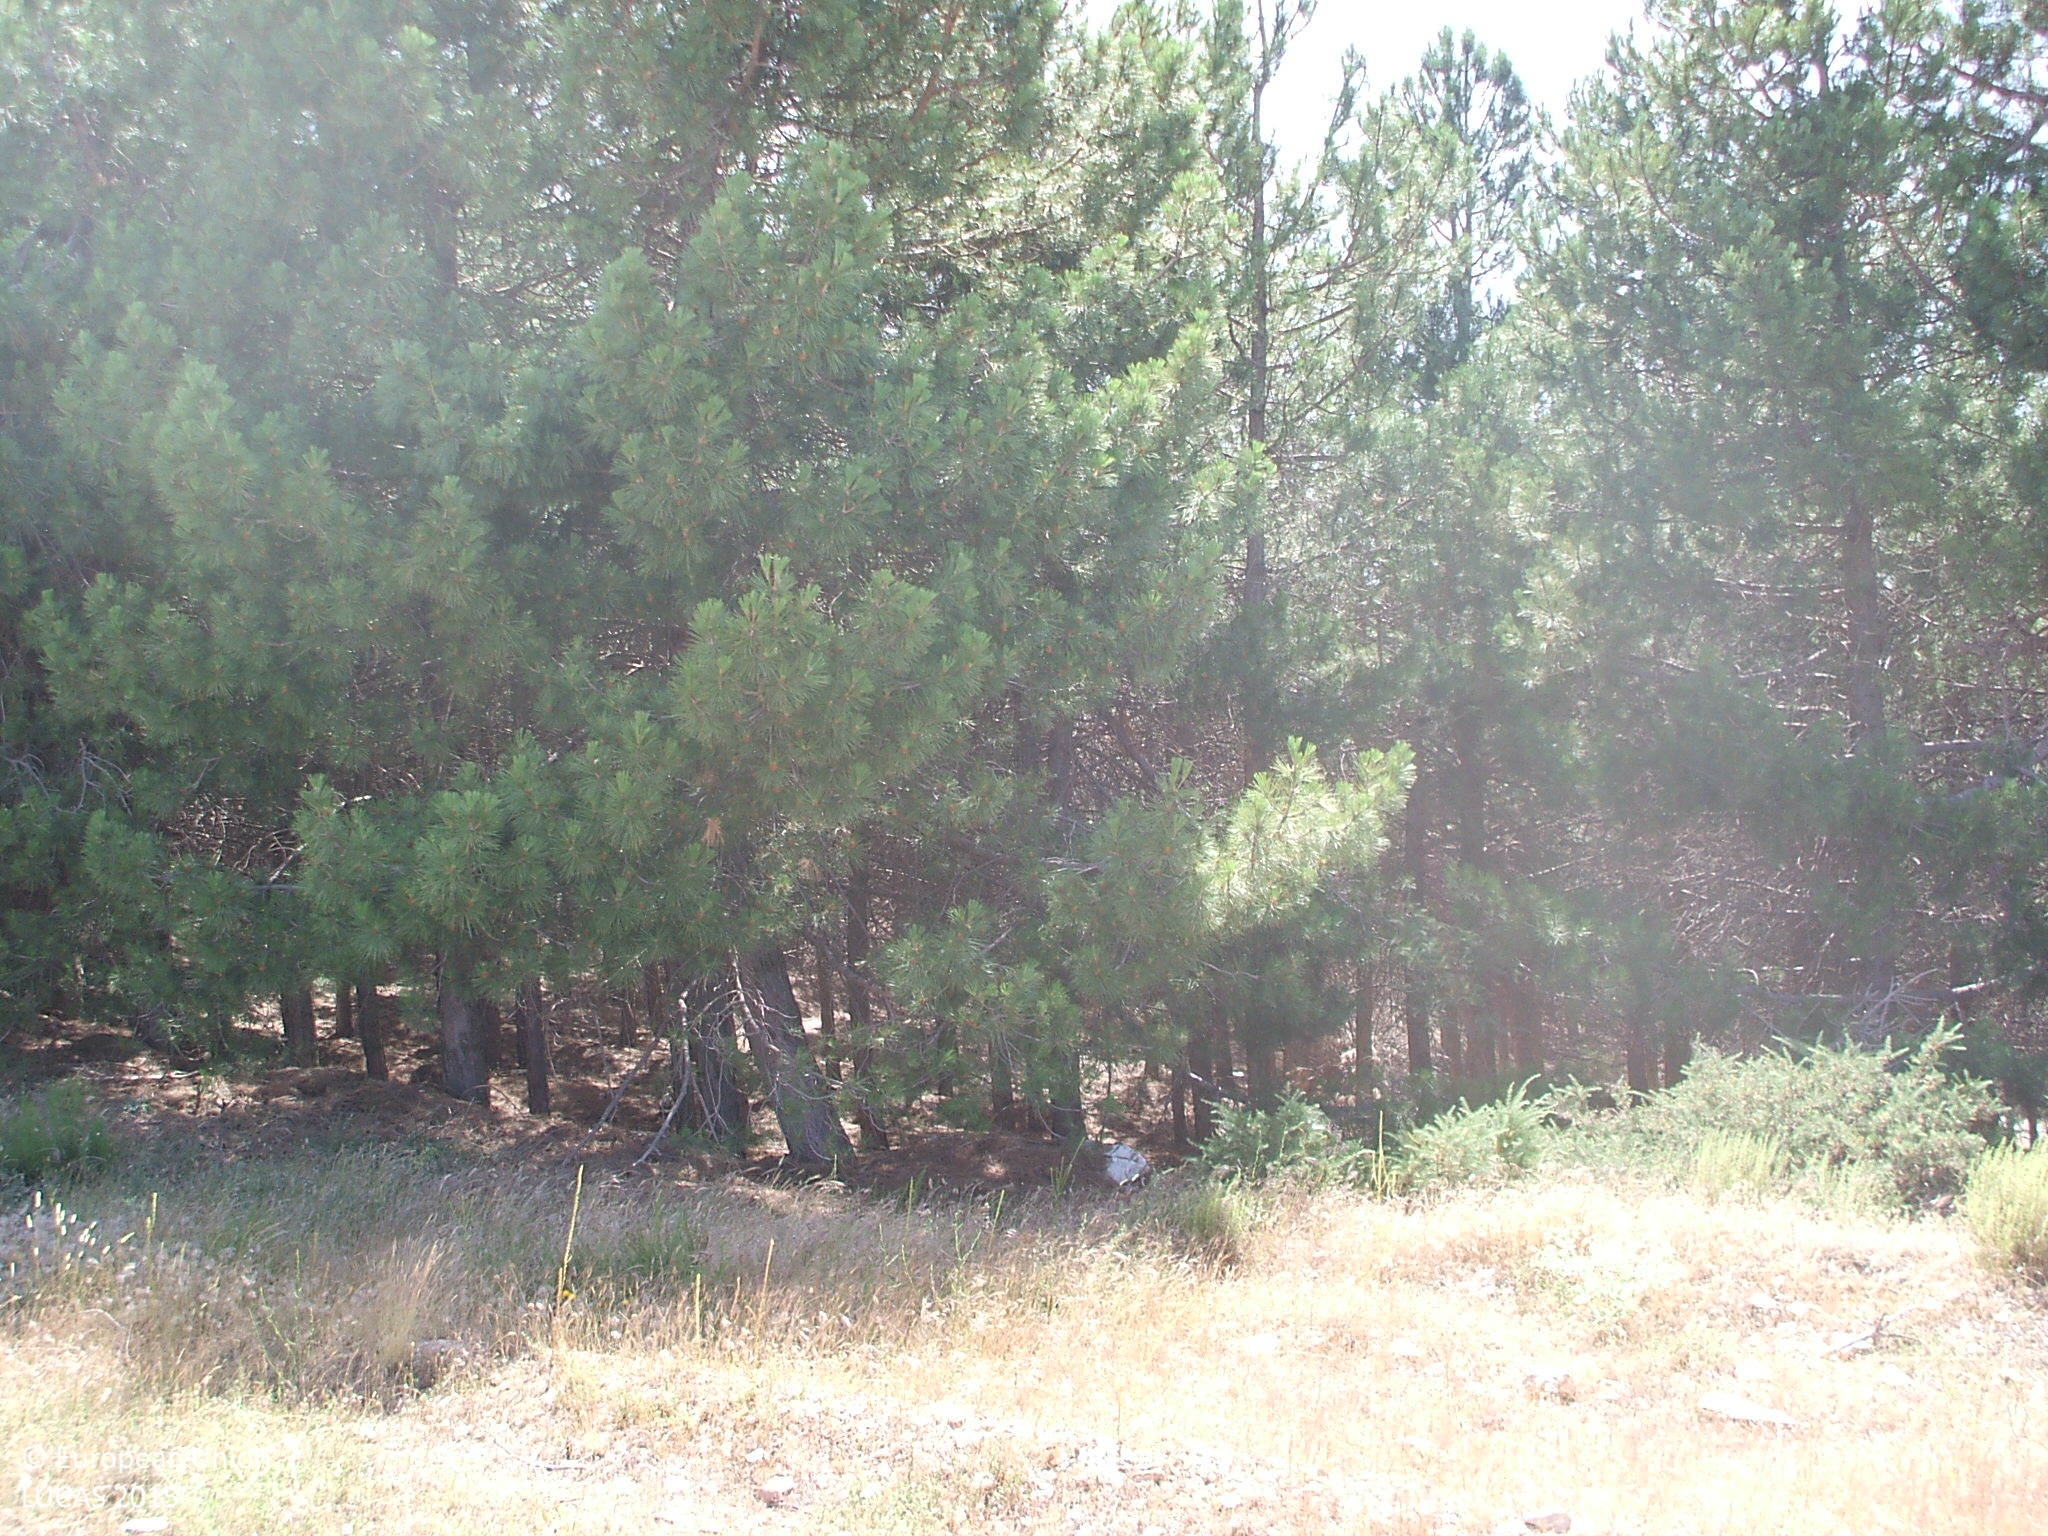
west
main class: Grassland
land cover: Grassland without tree/shrub cover
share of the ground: > 75 %
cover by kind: herbaceous plants 75 %, unconsolidated bare surface 15 %, shrubs 5 %, consolidated bare surface 5 %
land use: Forestry
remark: Fire break
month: July
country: ES
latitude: 37.2480
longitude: -2.3705
